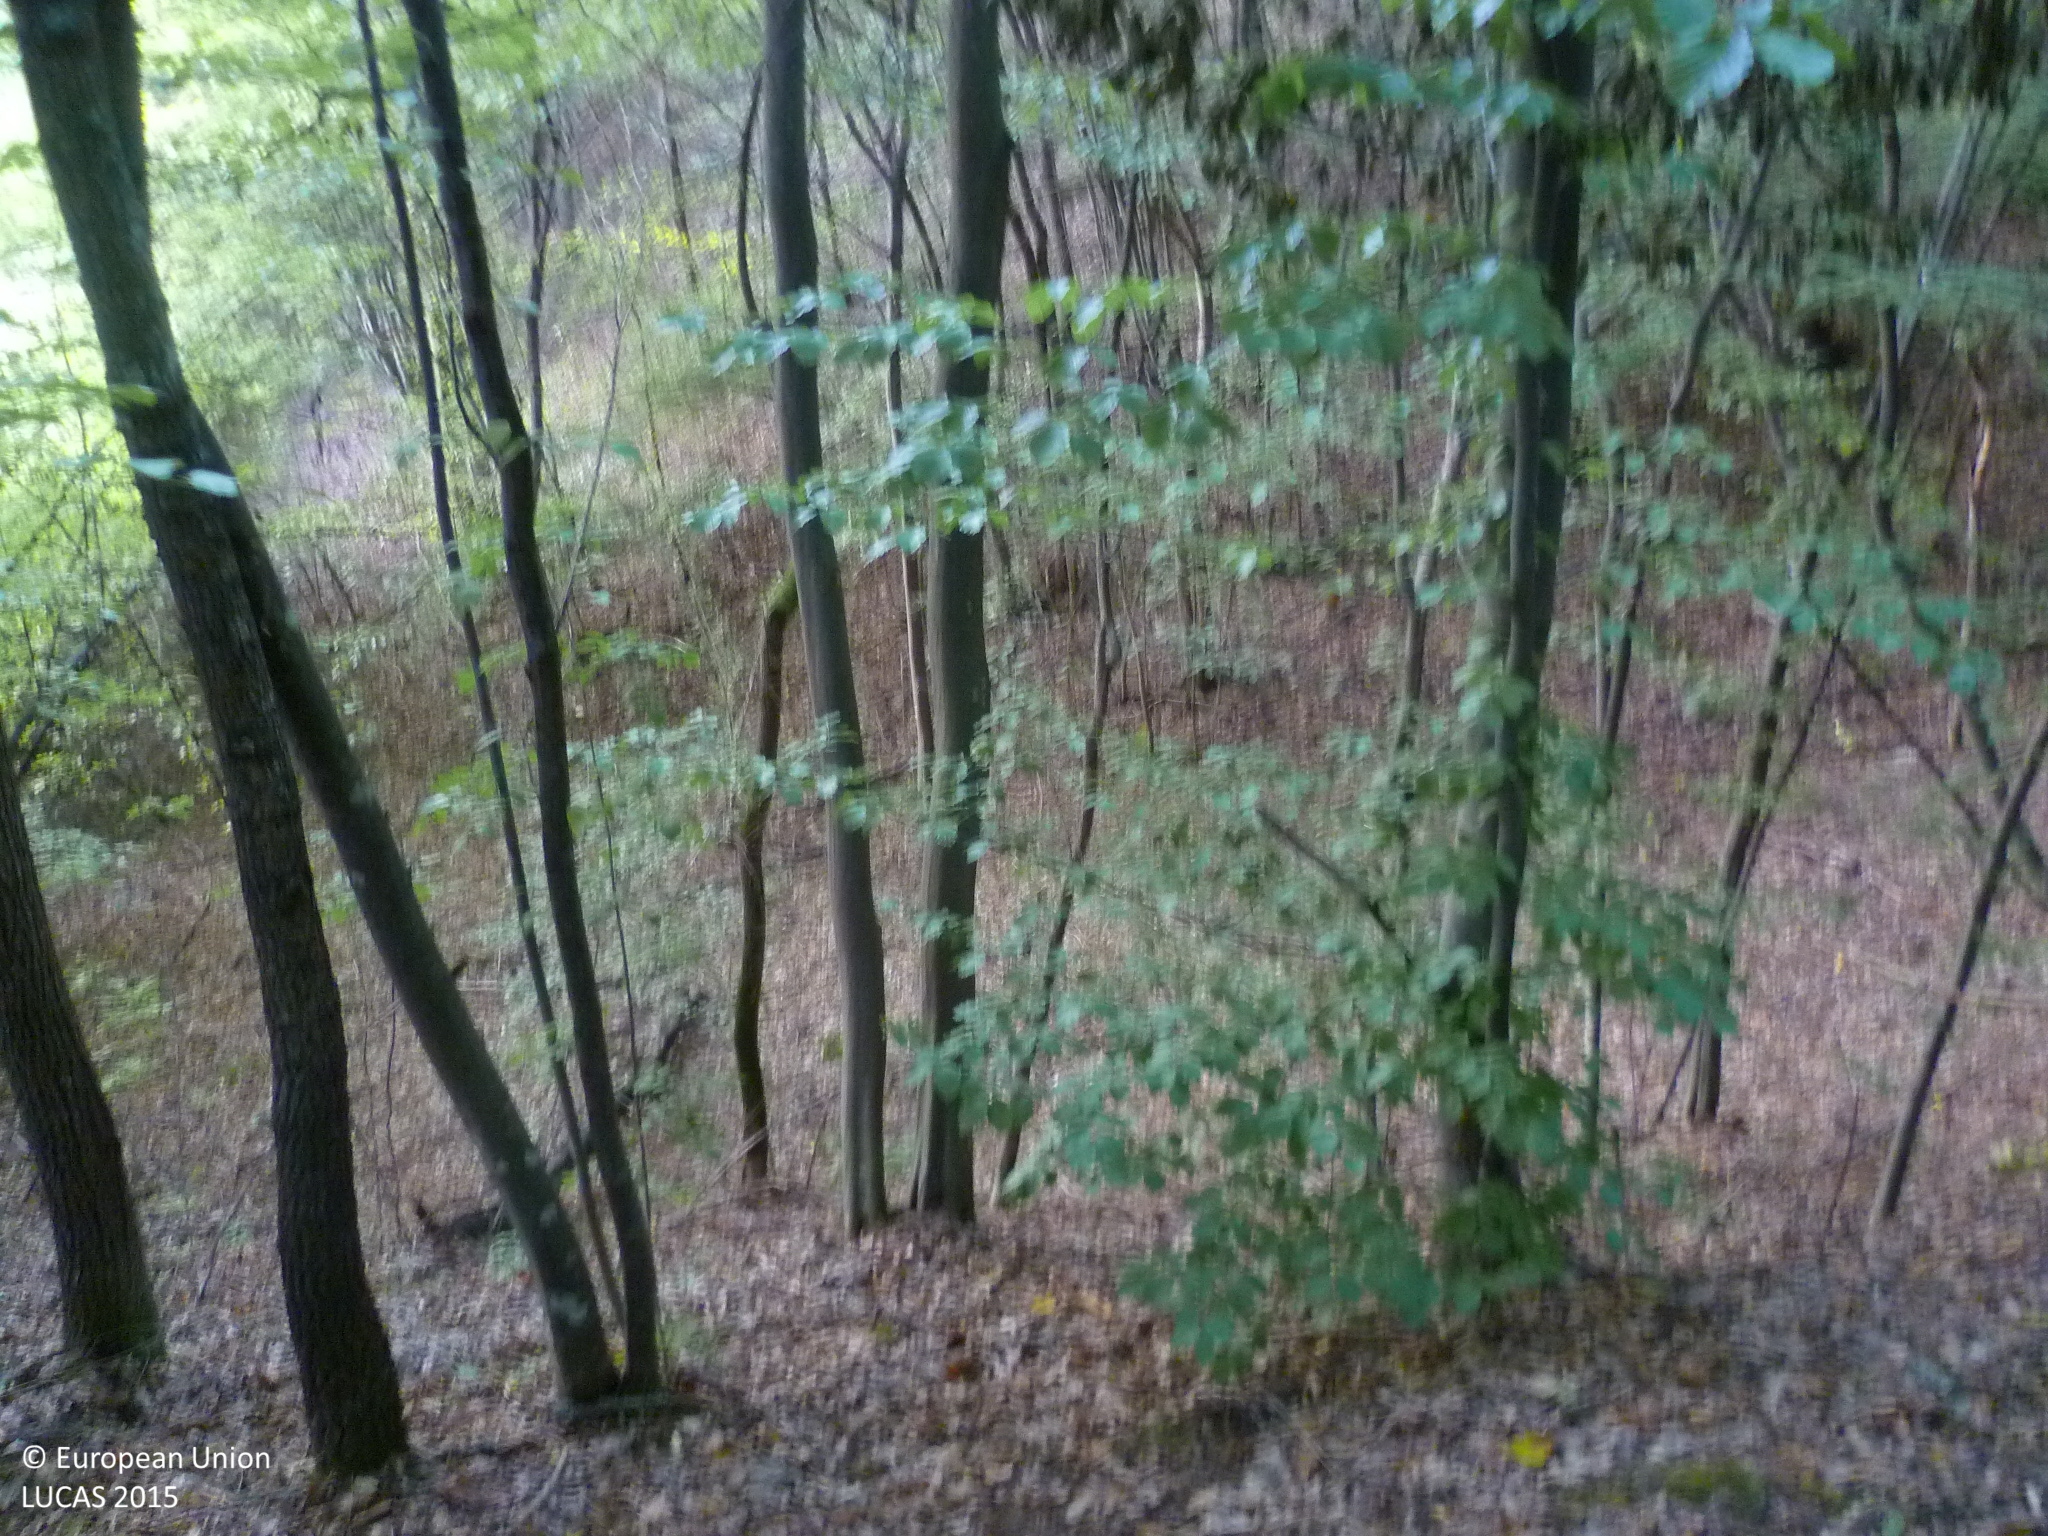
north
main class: Woodland
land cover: Broadleaved woodland
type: mesophytic deciduous forest
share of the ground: > 75 %
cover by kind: broadleaved forest trees 80 %, unconsolidated bare surface 20 %
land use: Forestry
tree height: > 5 m
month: October
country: BG
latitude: 42.8823
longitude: 22.7738
